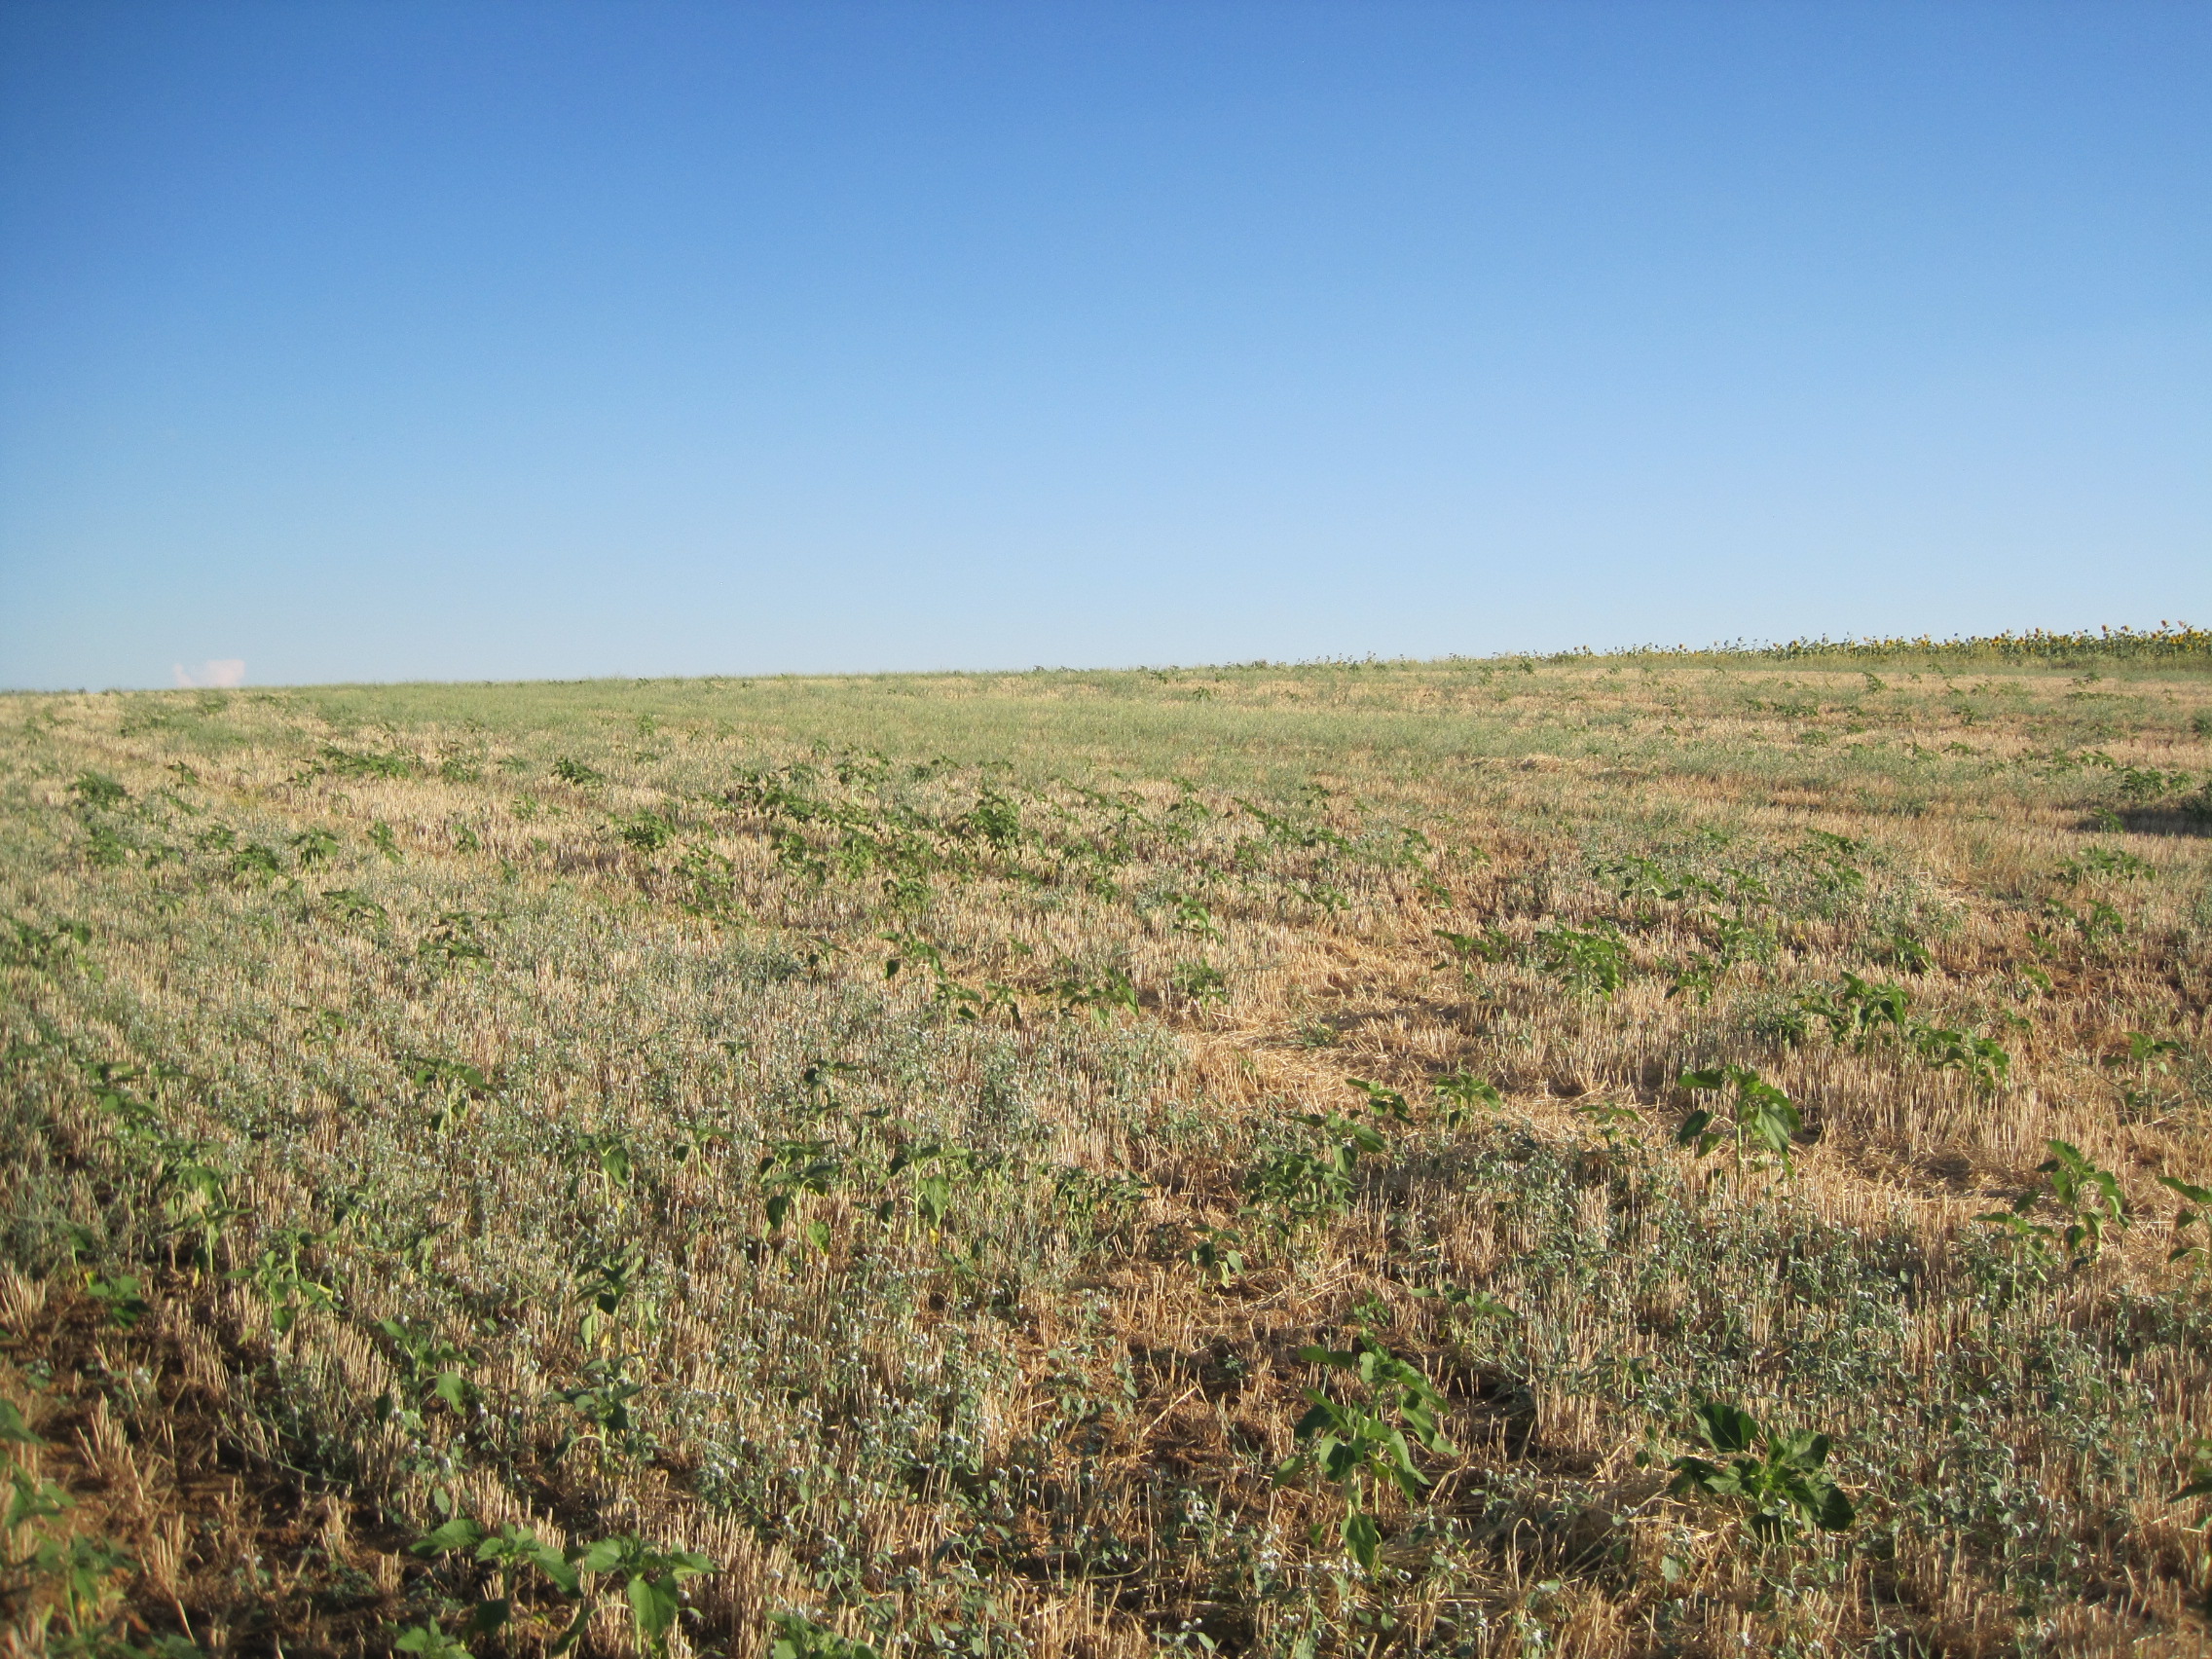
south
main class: Cropland
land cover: Barley
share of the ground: < 10 %
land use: Agriculture (excluding fallow land and kitchen gardens)
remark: Harvested field
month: July
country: ES
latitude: 42.1168
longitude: -5.2394
